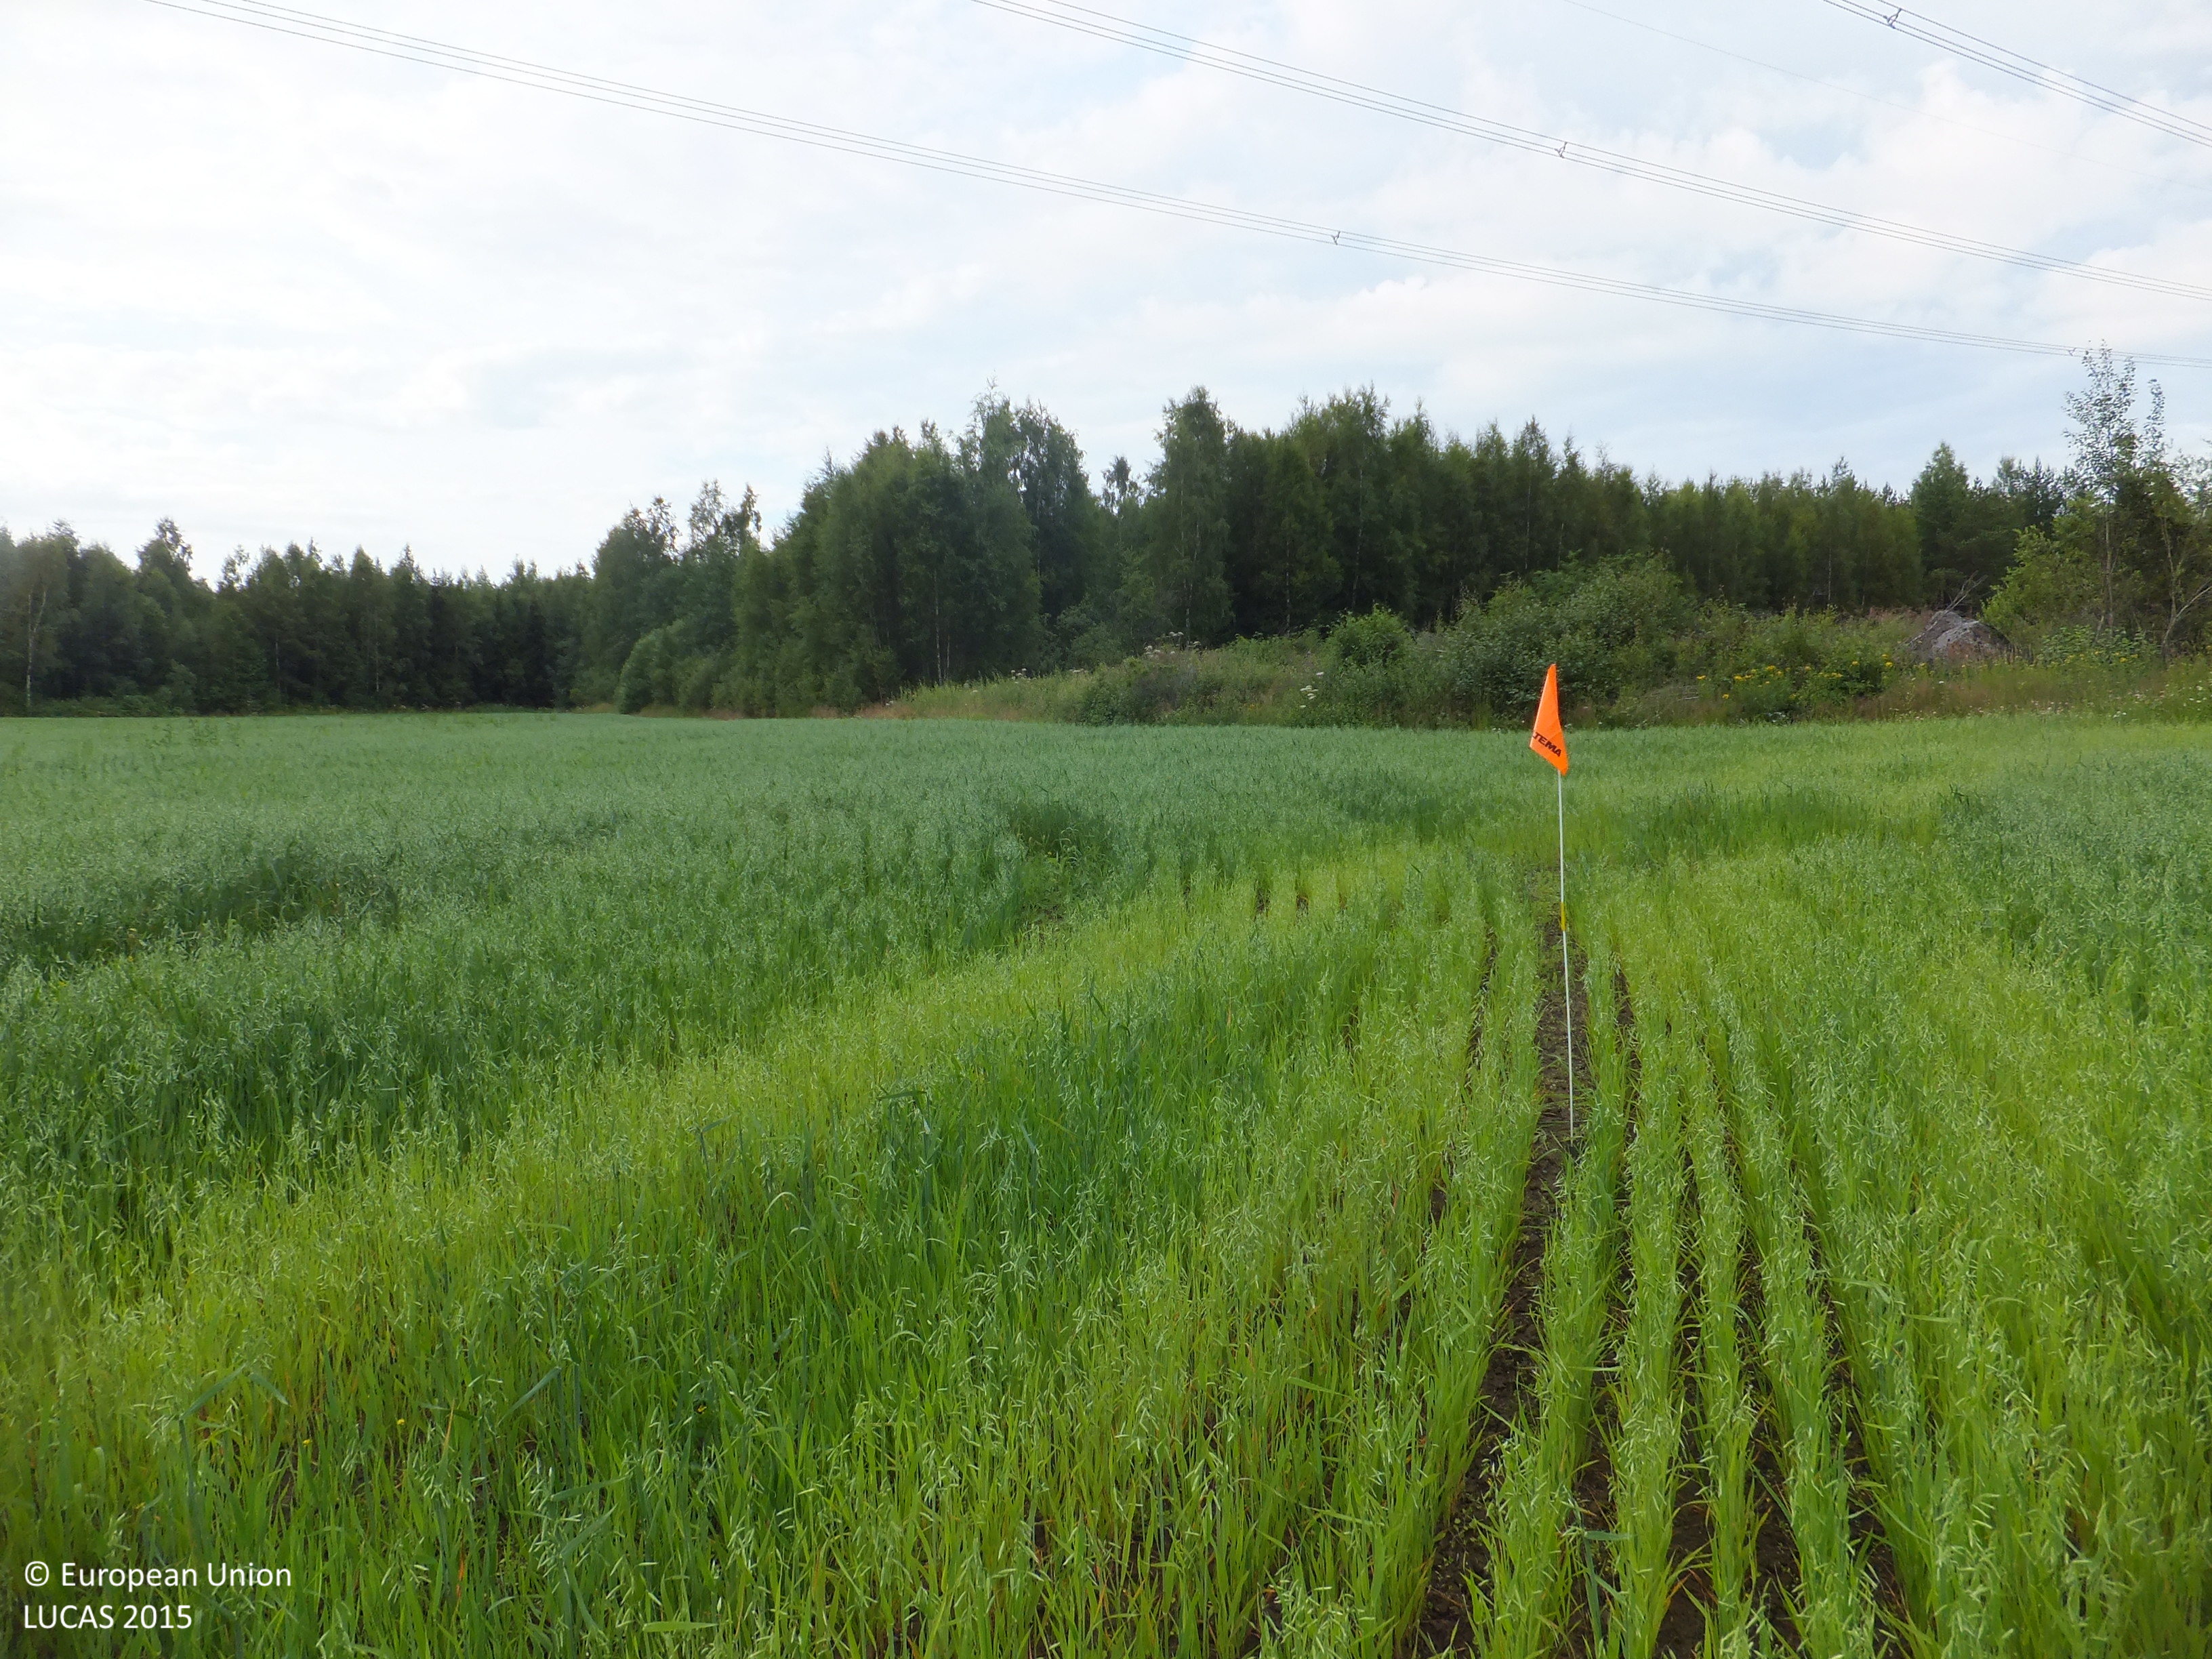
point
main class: Artificial land
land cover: Other artificial areas
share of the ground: > 75 %
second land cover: Oats
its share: > 75 %
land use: Electricity, gas and thermal power distribution
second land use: Agriculture (excluding fallow land and kitchen gardens)
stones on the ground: < 10 %
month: July
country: FI
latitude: 63.0709
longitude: 21.8986
